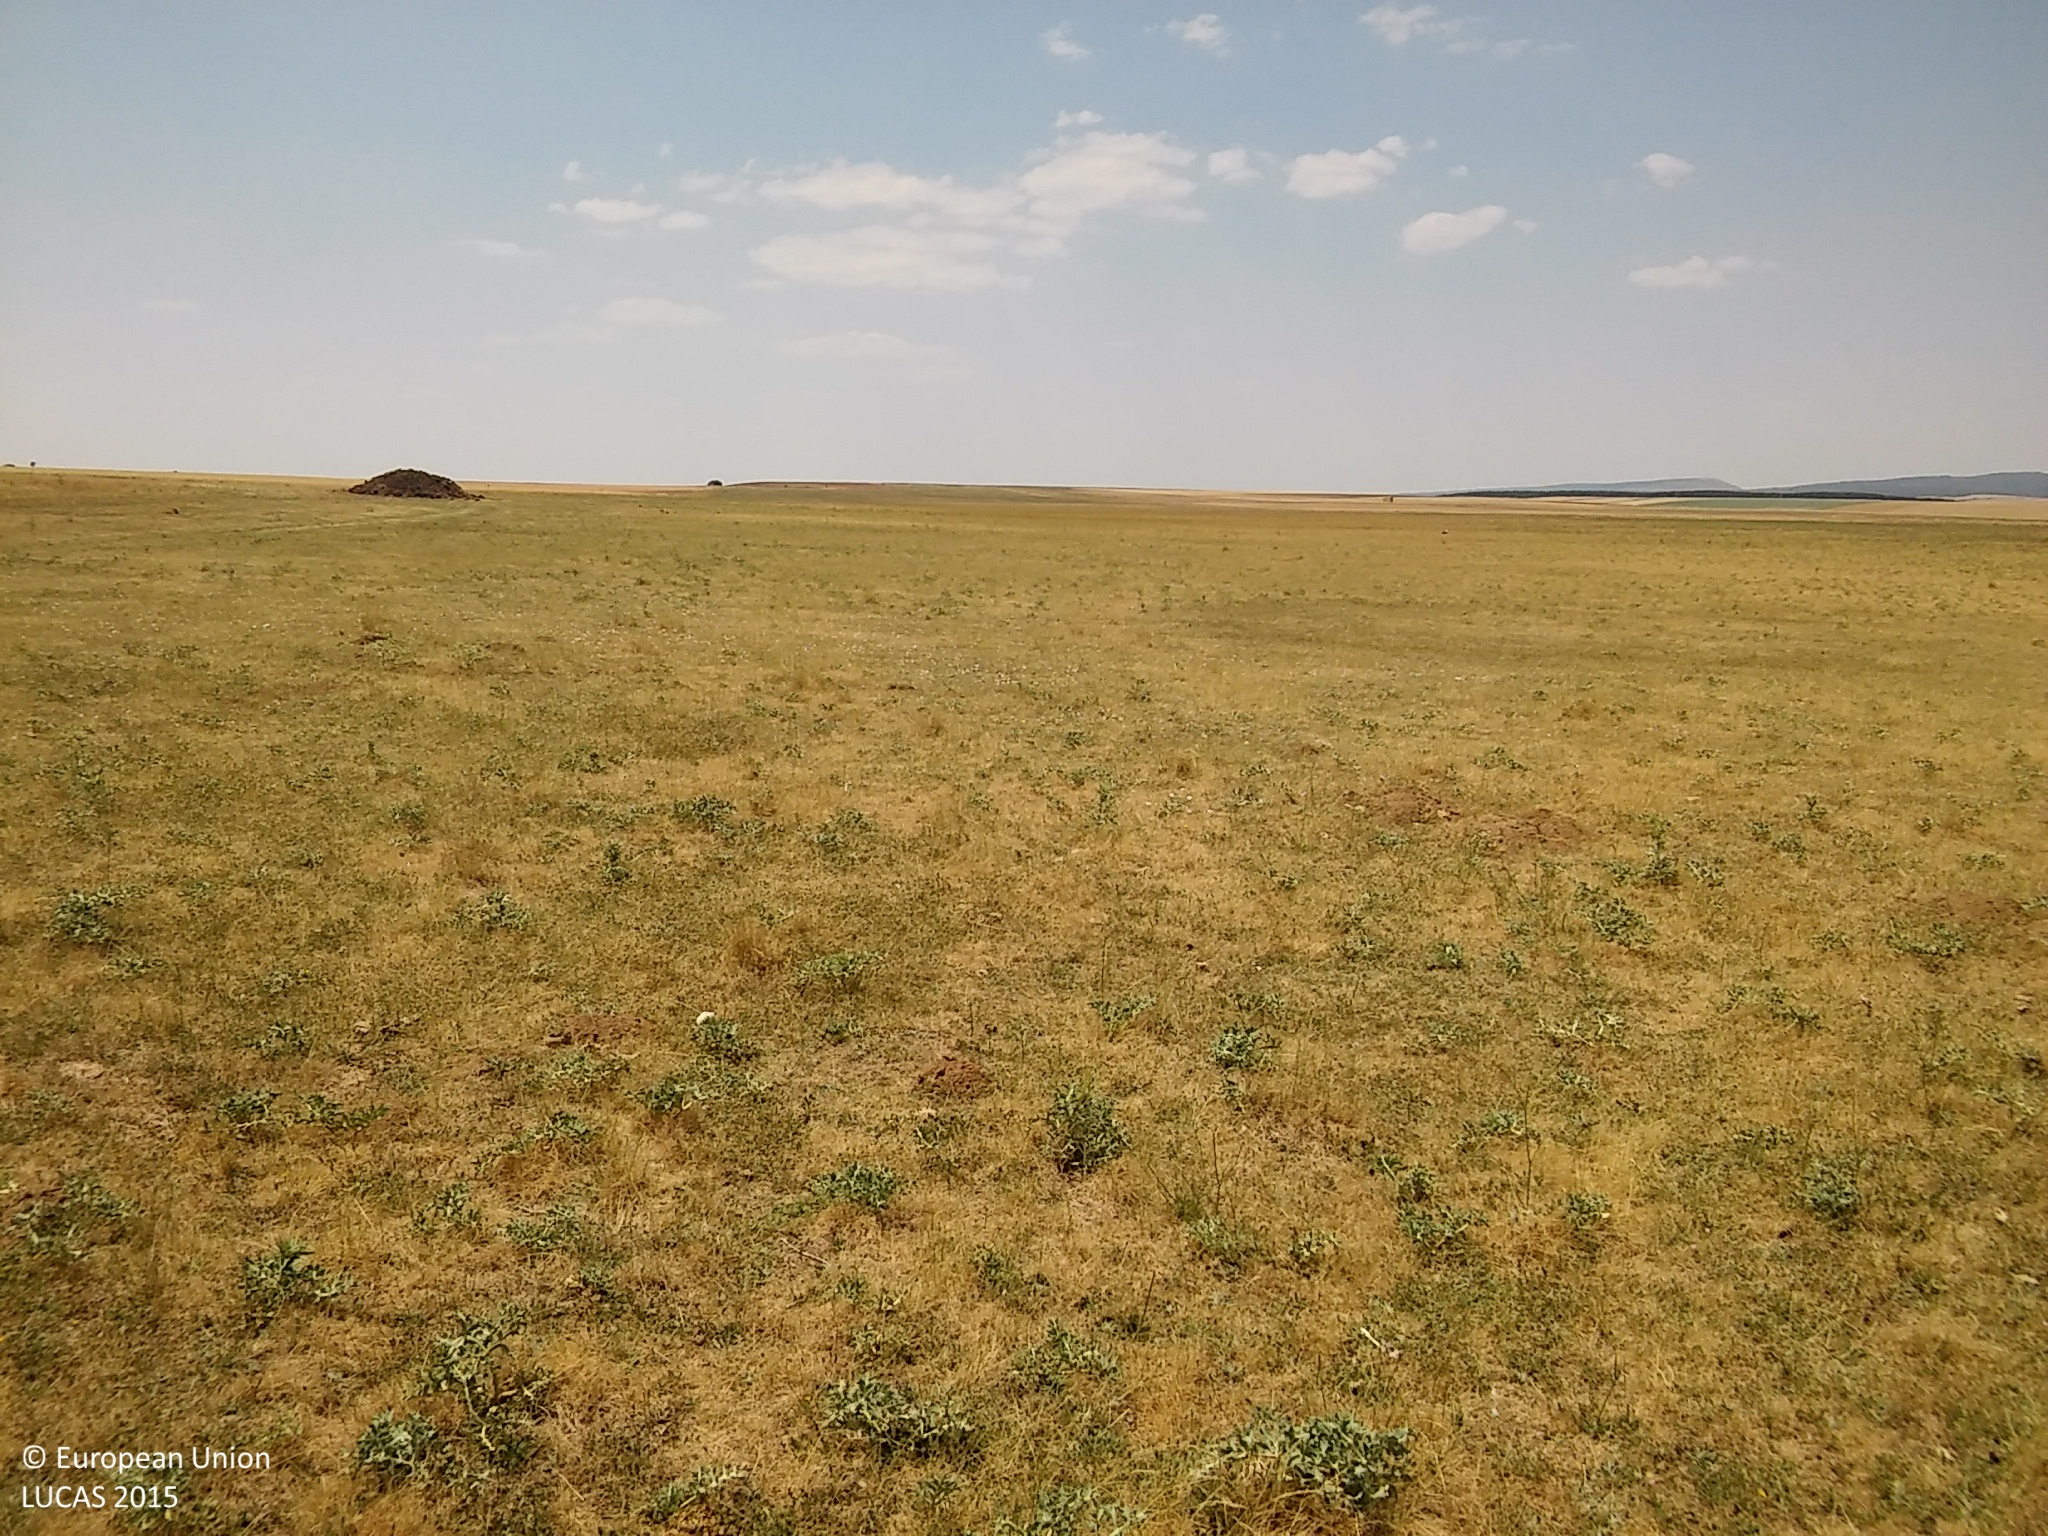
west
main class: Grassland
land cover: Grassland without tree/shrub cover
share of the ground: > 75 %
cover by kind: herbaceous plants 100 %
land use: Agriculture (excluding fallow land and kitchen gardens)
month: June
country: ES
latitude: 41.4123
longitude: -3.5302
